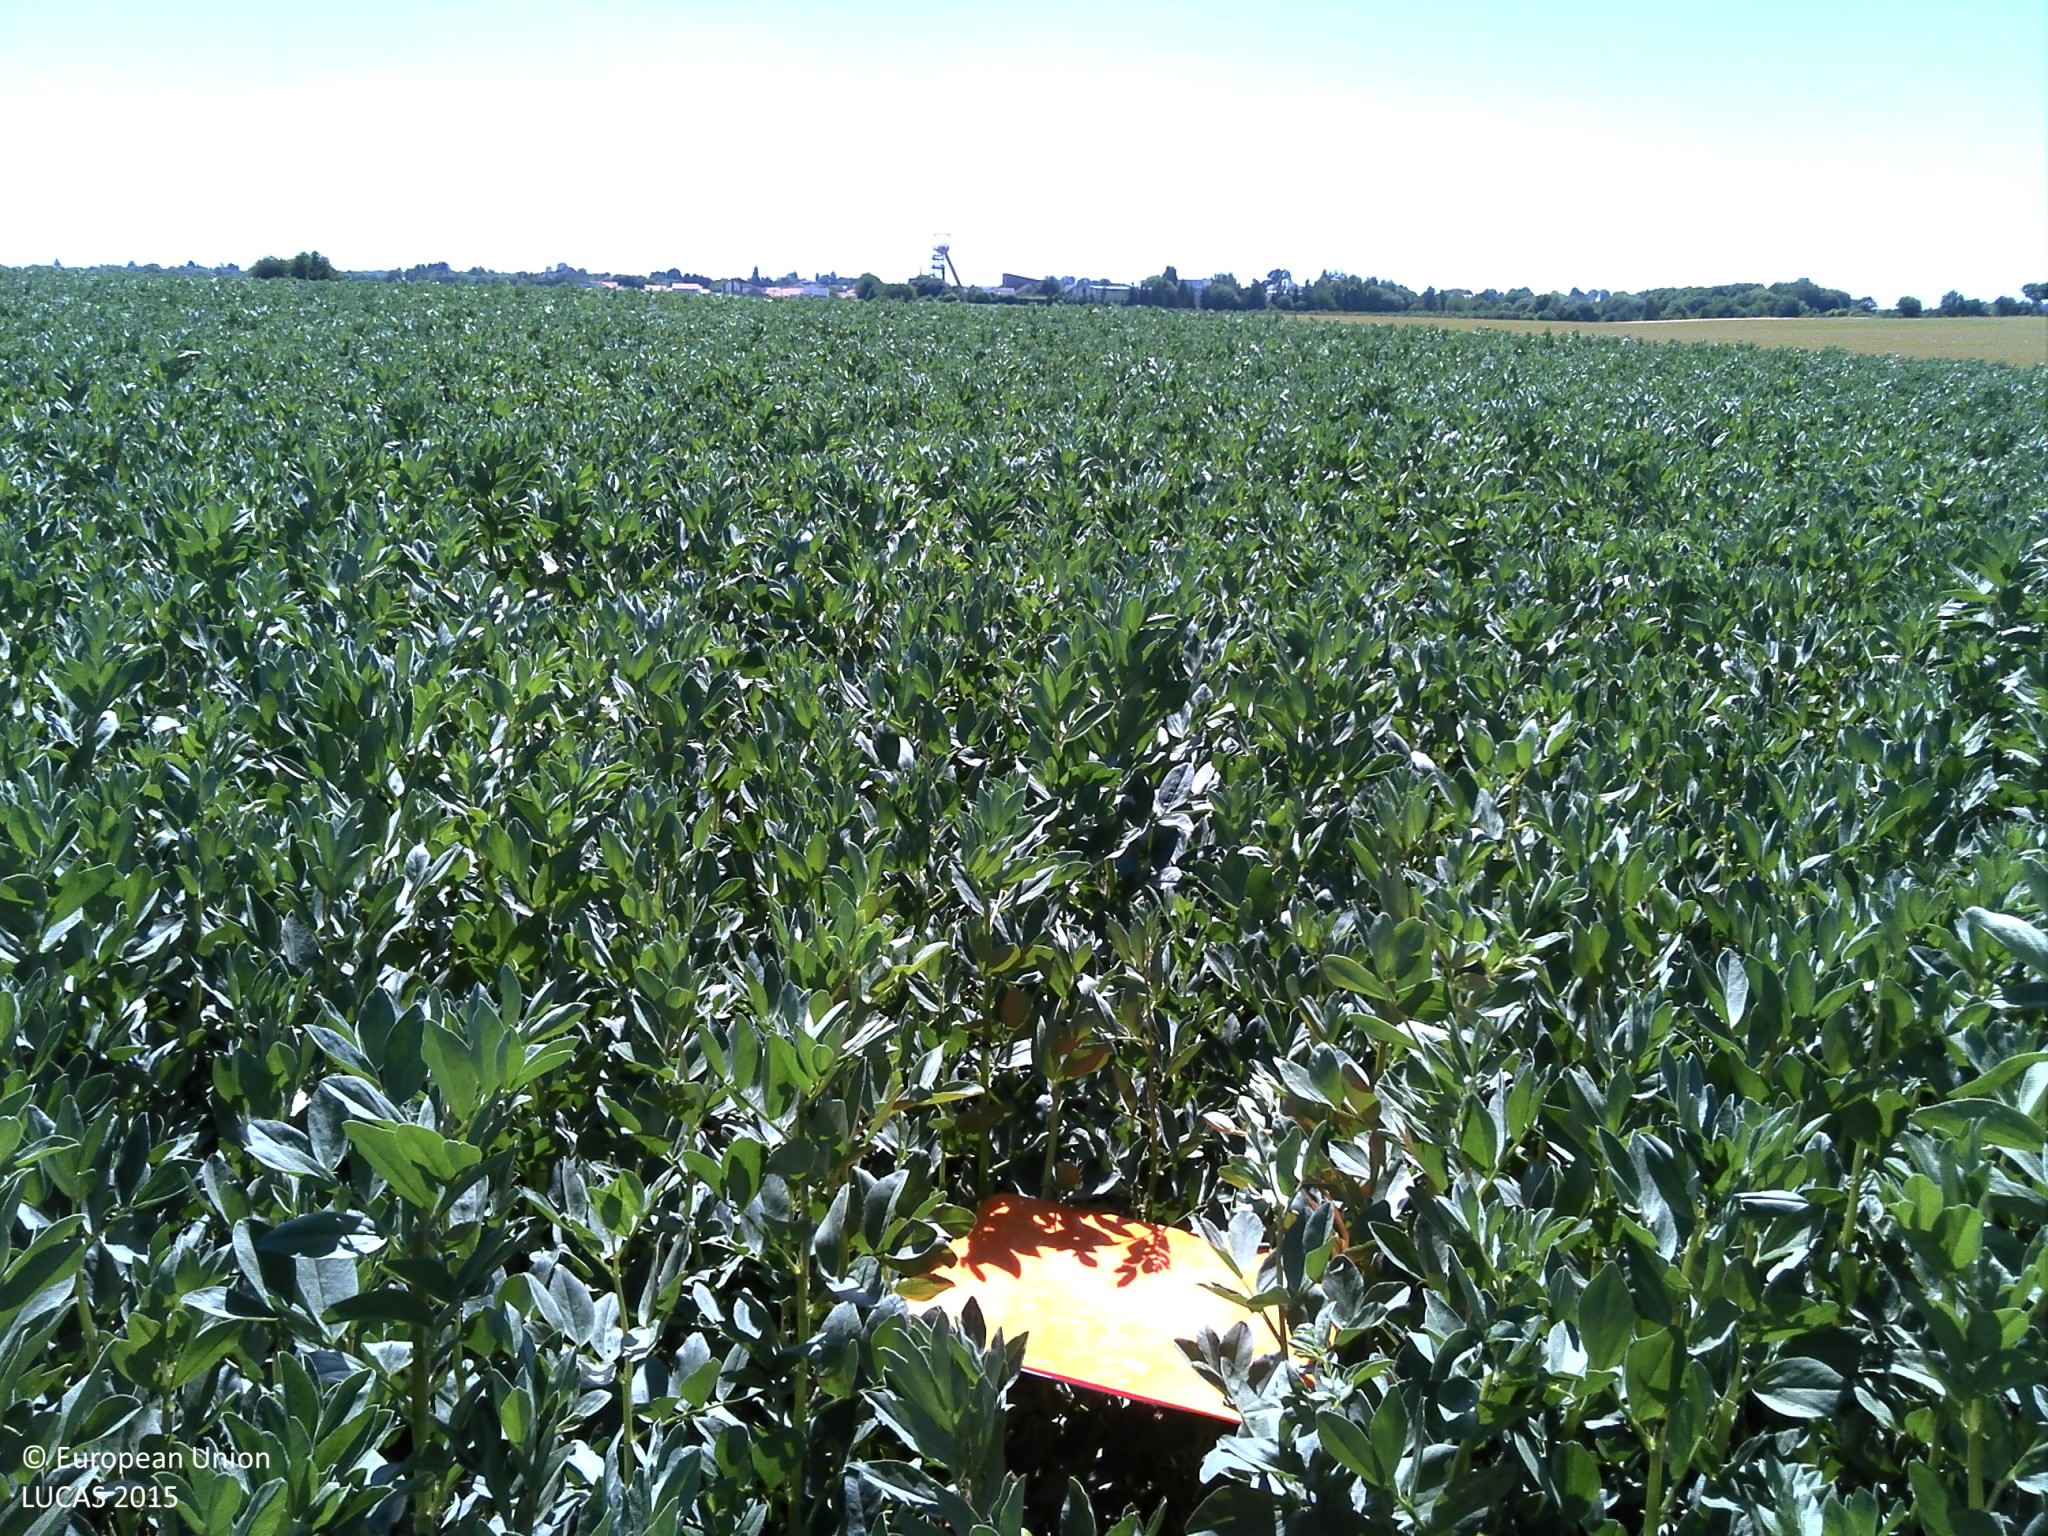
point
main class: Cropland
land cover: Dry pulses
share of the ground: > 75 %
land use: Agriculture (excluding fallow land and kitchen gardens)
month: June
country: FR
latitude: 49.4284
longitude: 5.9595
